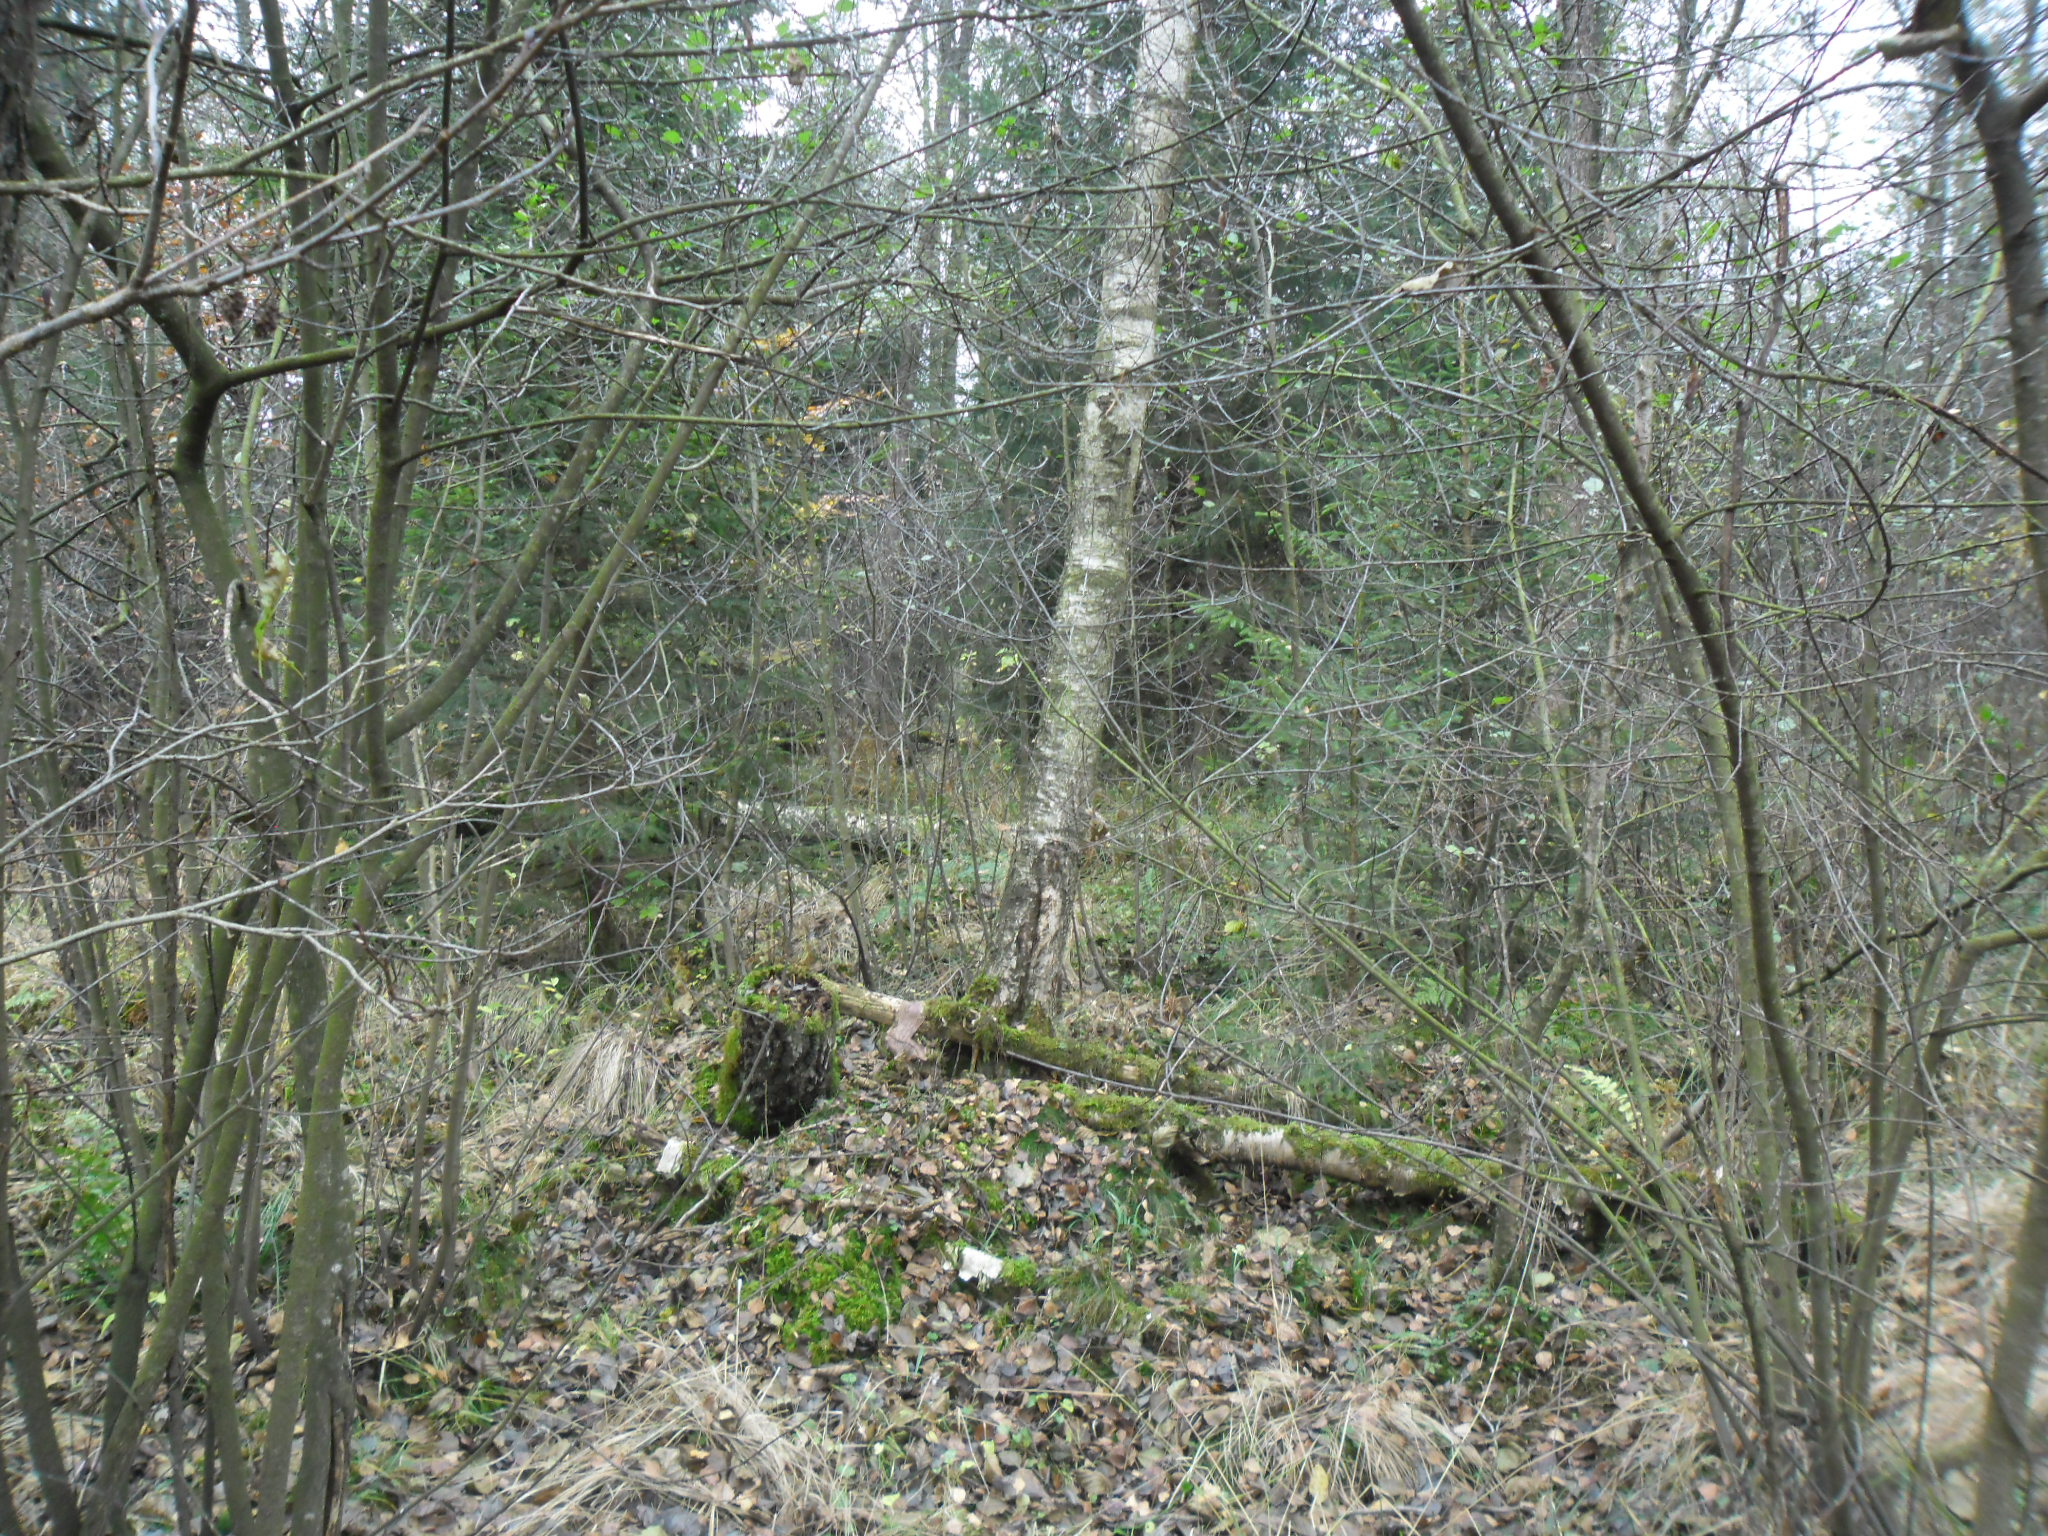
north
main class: Woodland
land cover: Other mixed woodland
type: boreal forest
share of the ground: > 75 %
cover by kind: broadleaved forest trees 60 %, coniferous forest trees 20 %, herbaceous plants 20 %
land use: Forestry
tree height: > 5 m
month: November
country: SE
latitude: 56.2939
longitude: 13.1157
